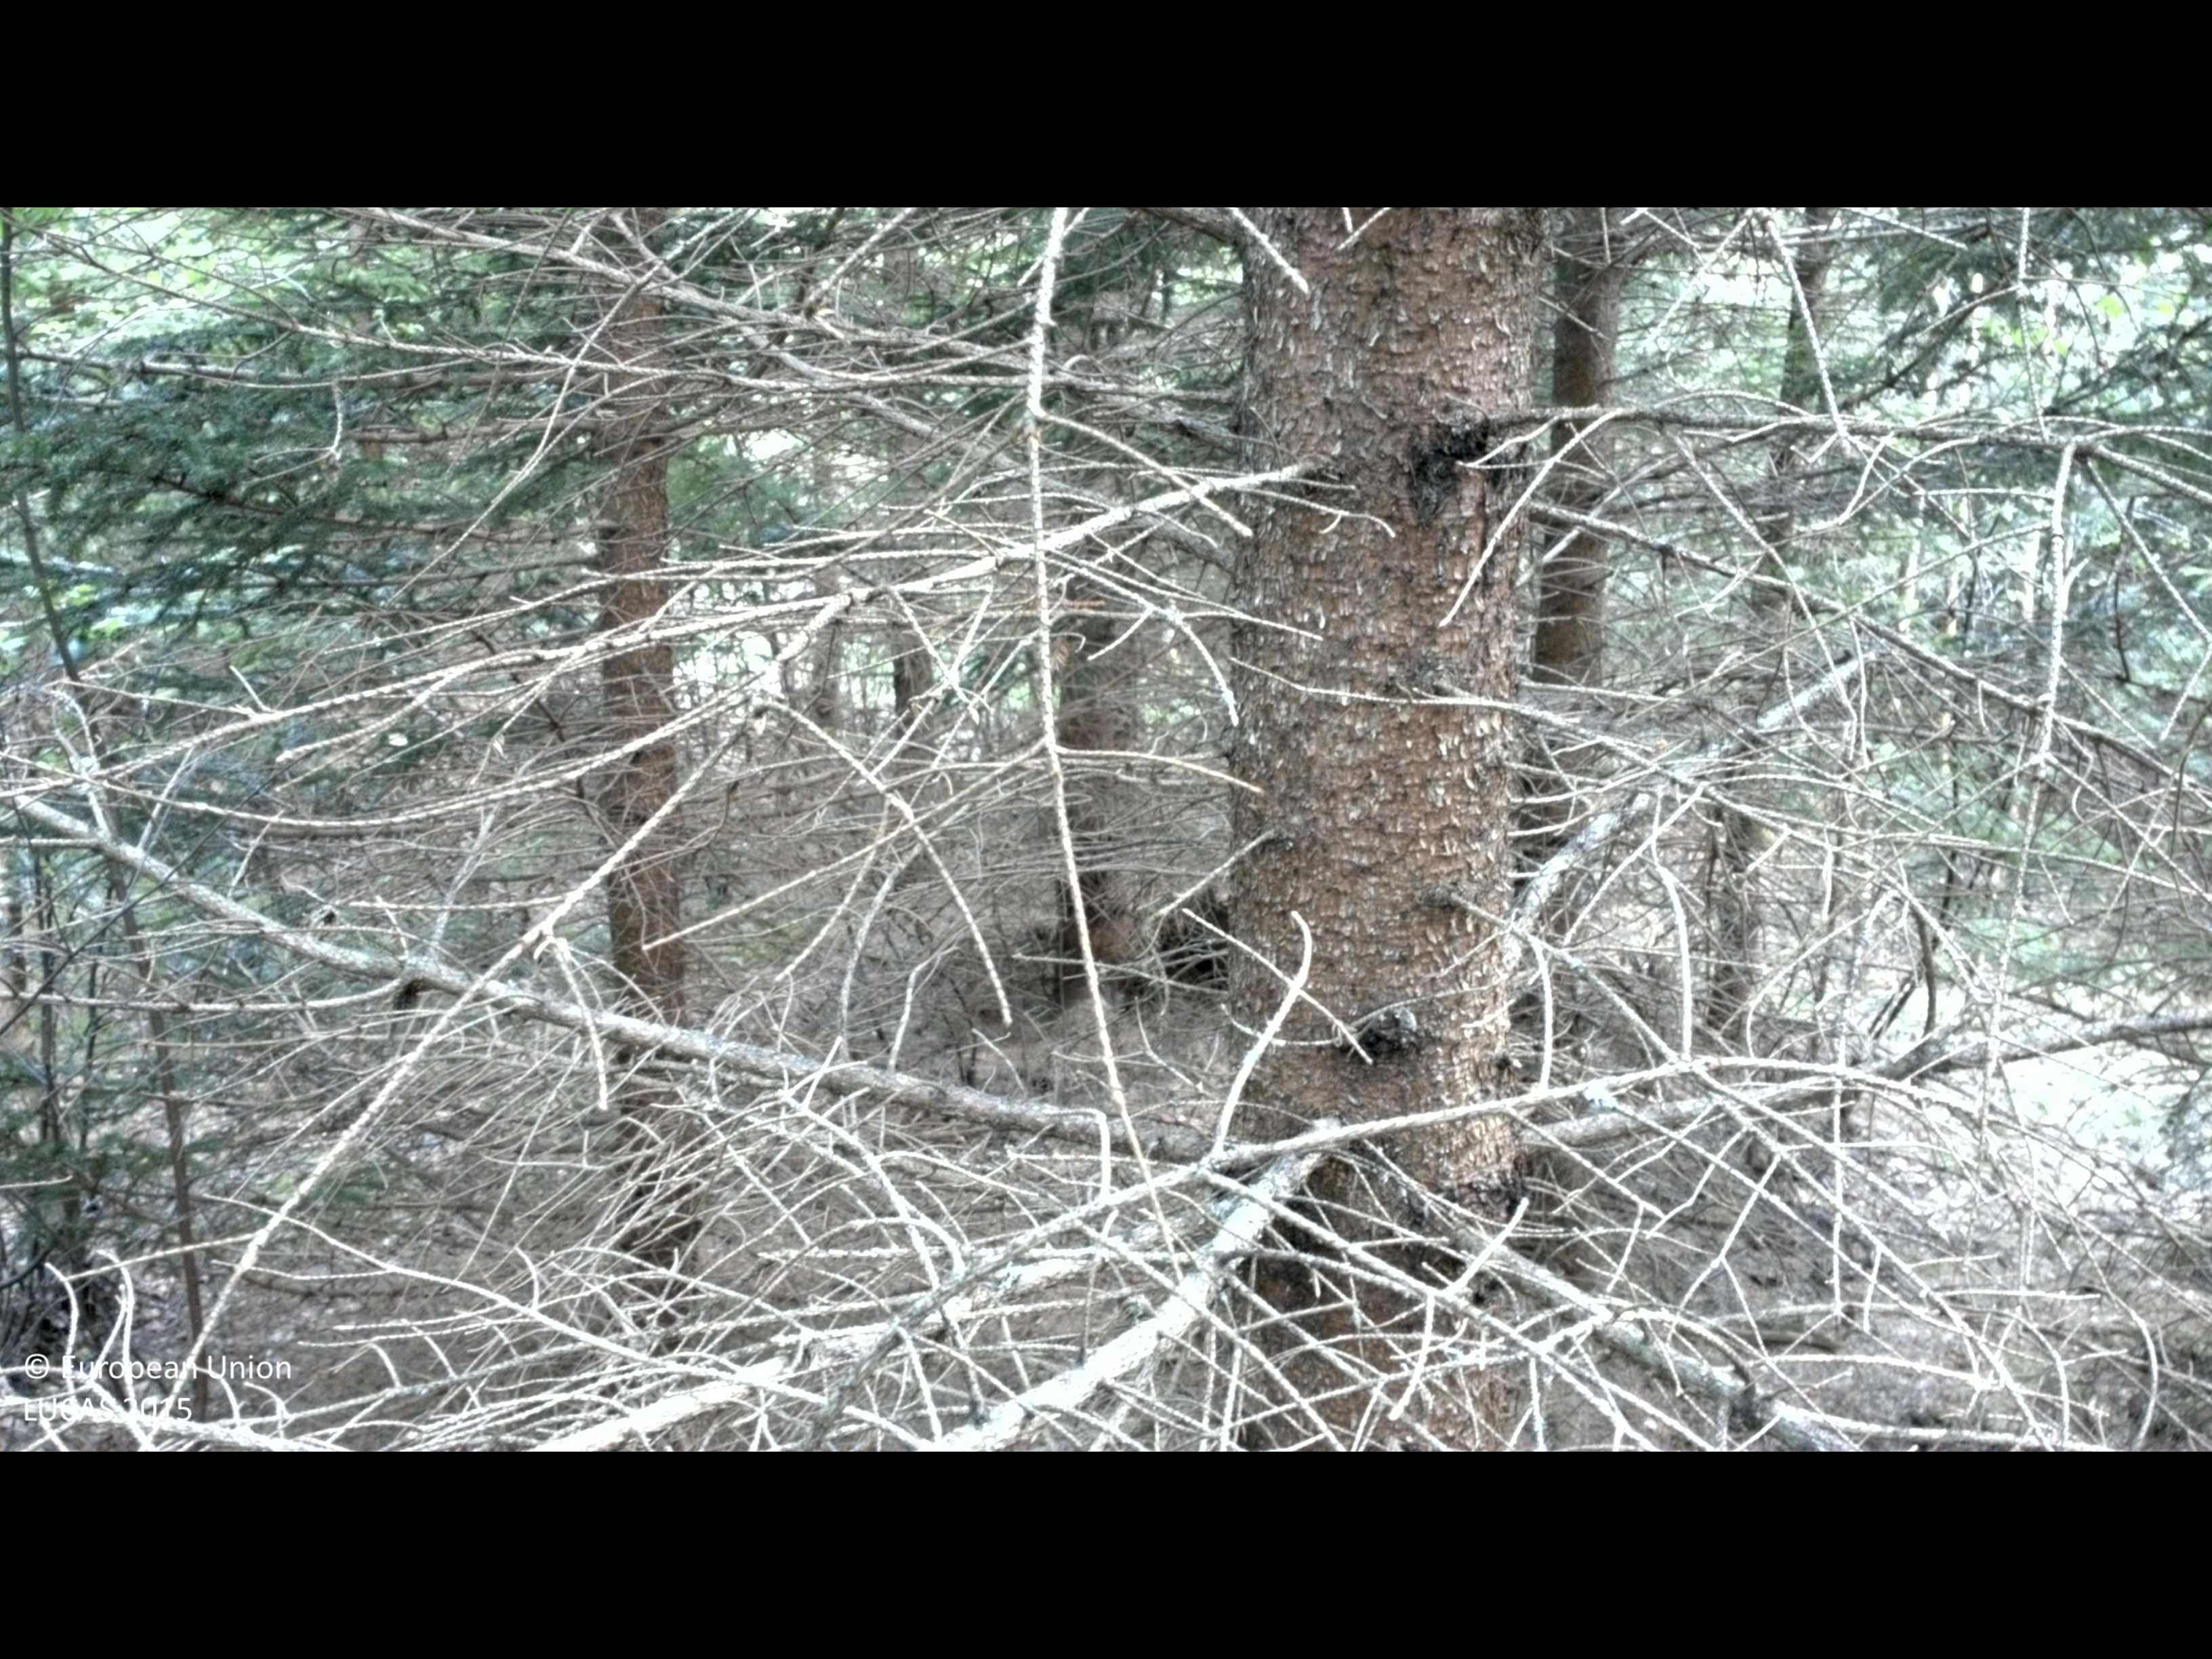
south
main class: Woodland
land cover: Spruce dominated coniferous woodland
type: boreal forest
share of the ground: > 75 %
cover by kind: coniferous forest trees 75 %, broadleaved forest trees 15 %, shrubs 5 %, lichens and mosses 5 %
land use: Forestry
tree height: > 5 m
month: July
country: SE
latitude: 58.3067
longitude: 16.6698
